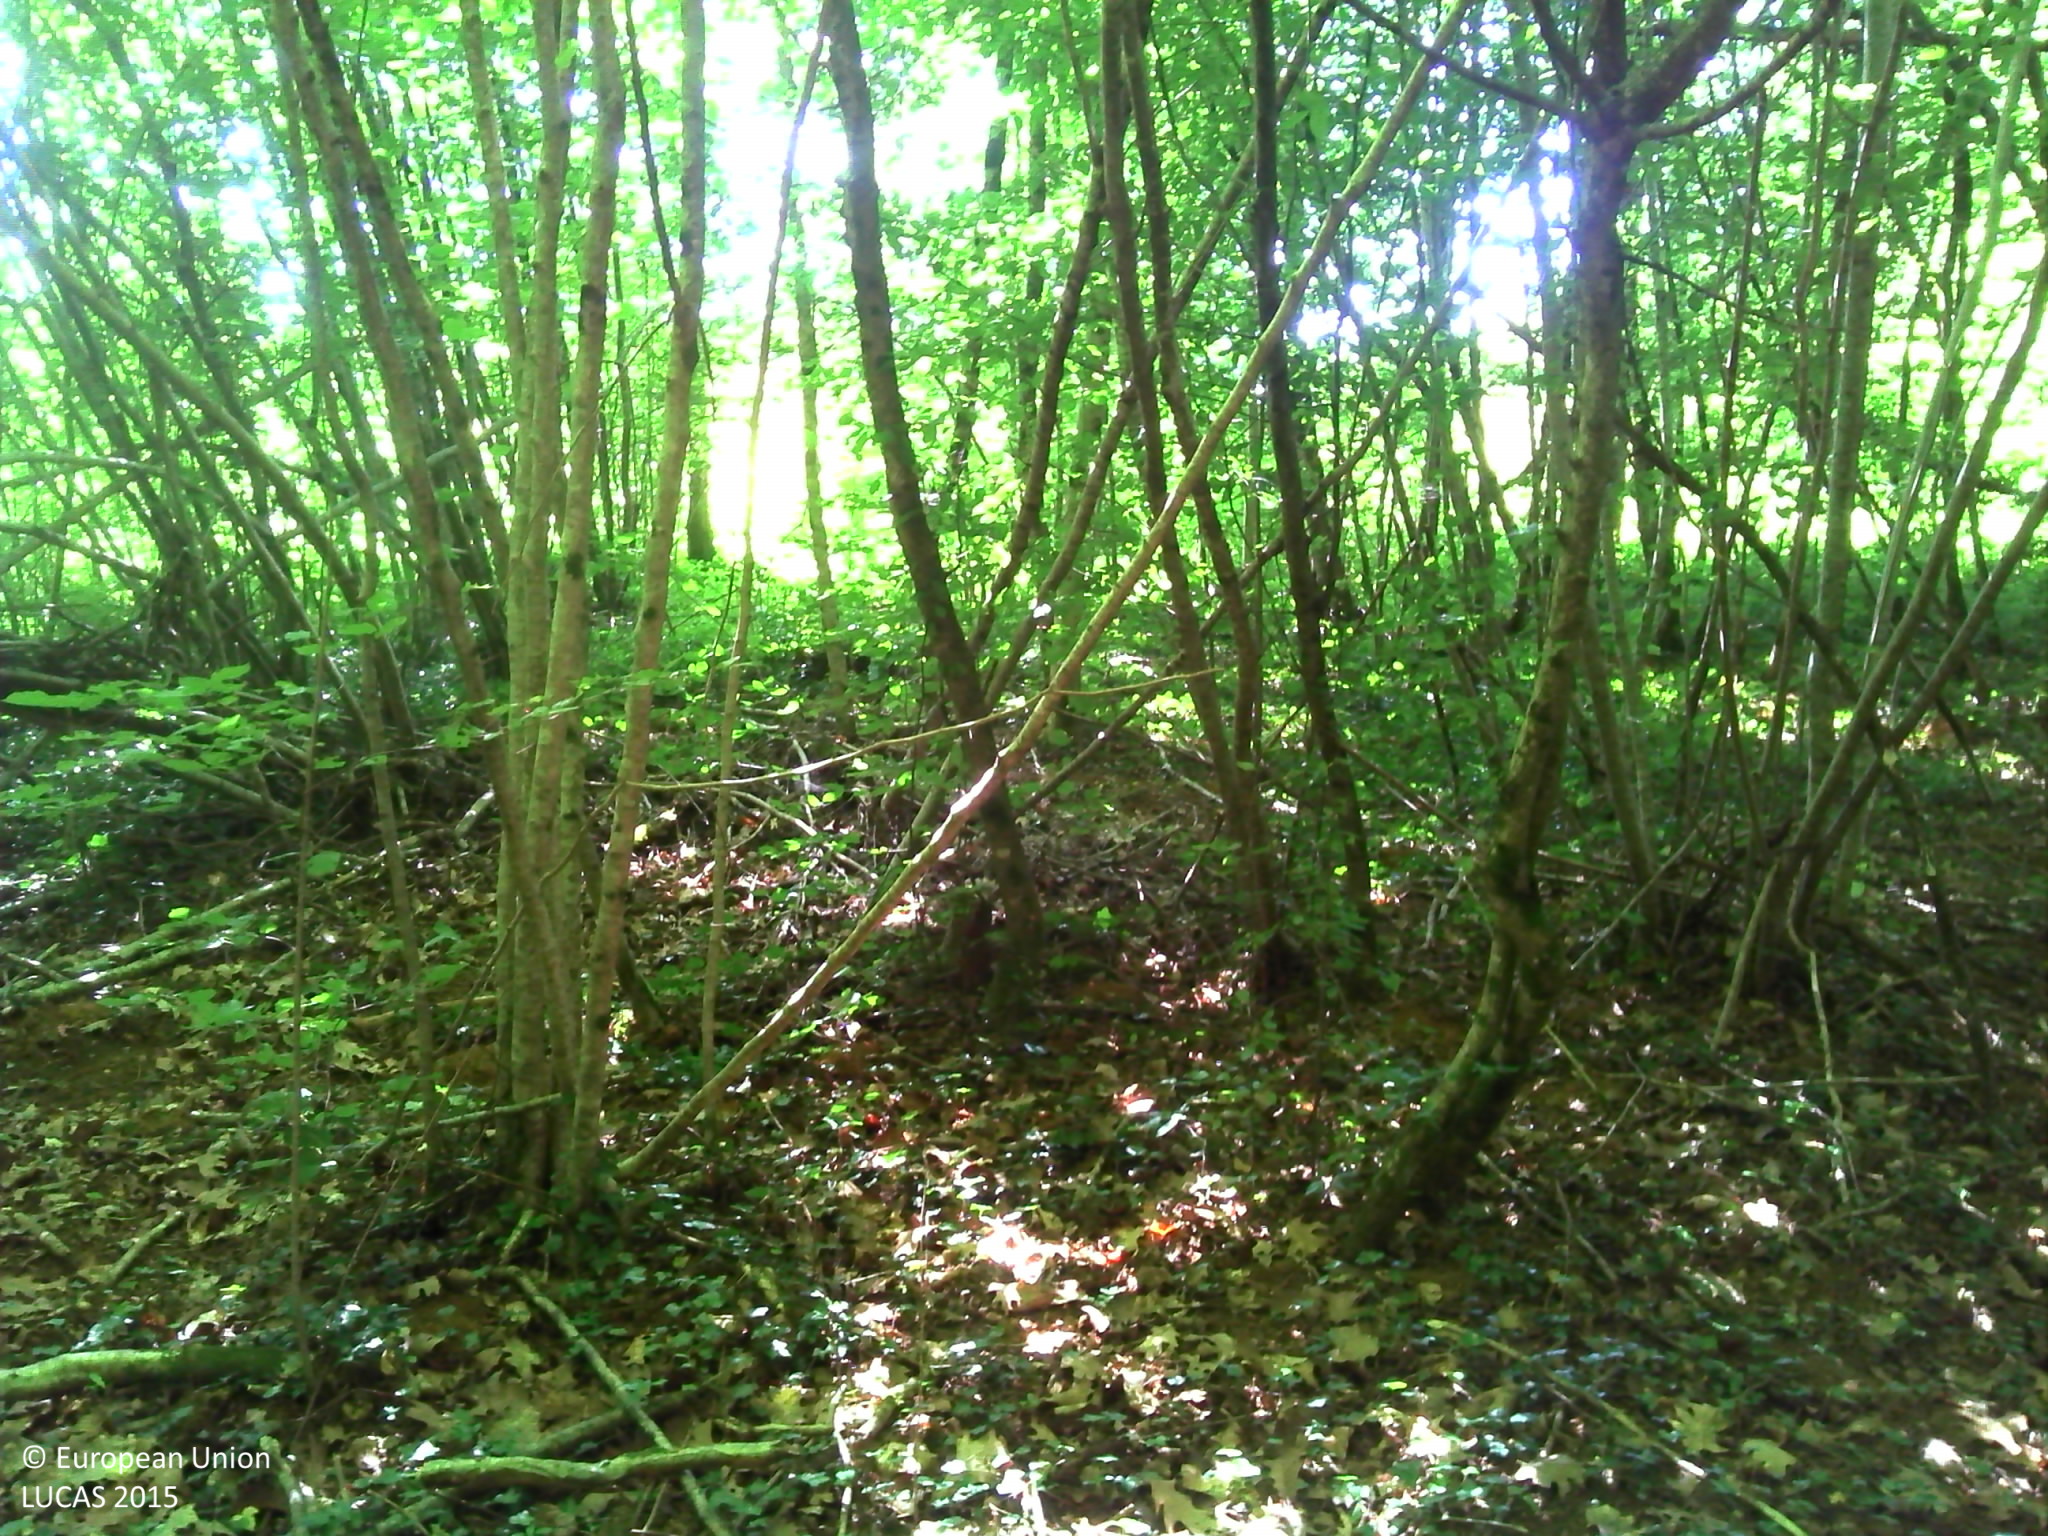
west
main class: Woodland
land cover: Broadleaved woodland
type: beech forest
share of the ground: > 75 %
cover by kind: broadleaved forest trees 90 %, shrubs 5 %, herbaceous plants 5 %
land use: Forestry
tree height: > 5 m
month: June
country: FR
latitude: 47.5073
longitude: 6.1378
